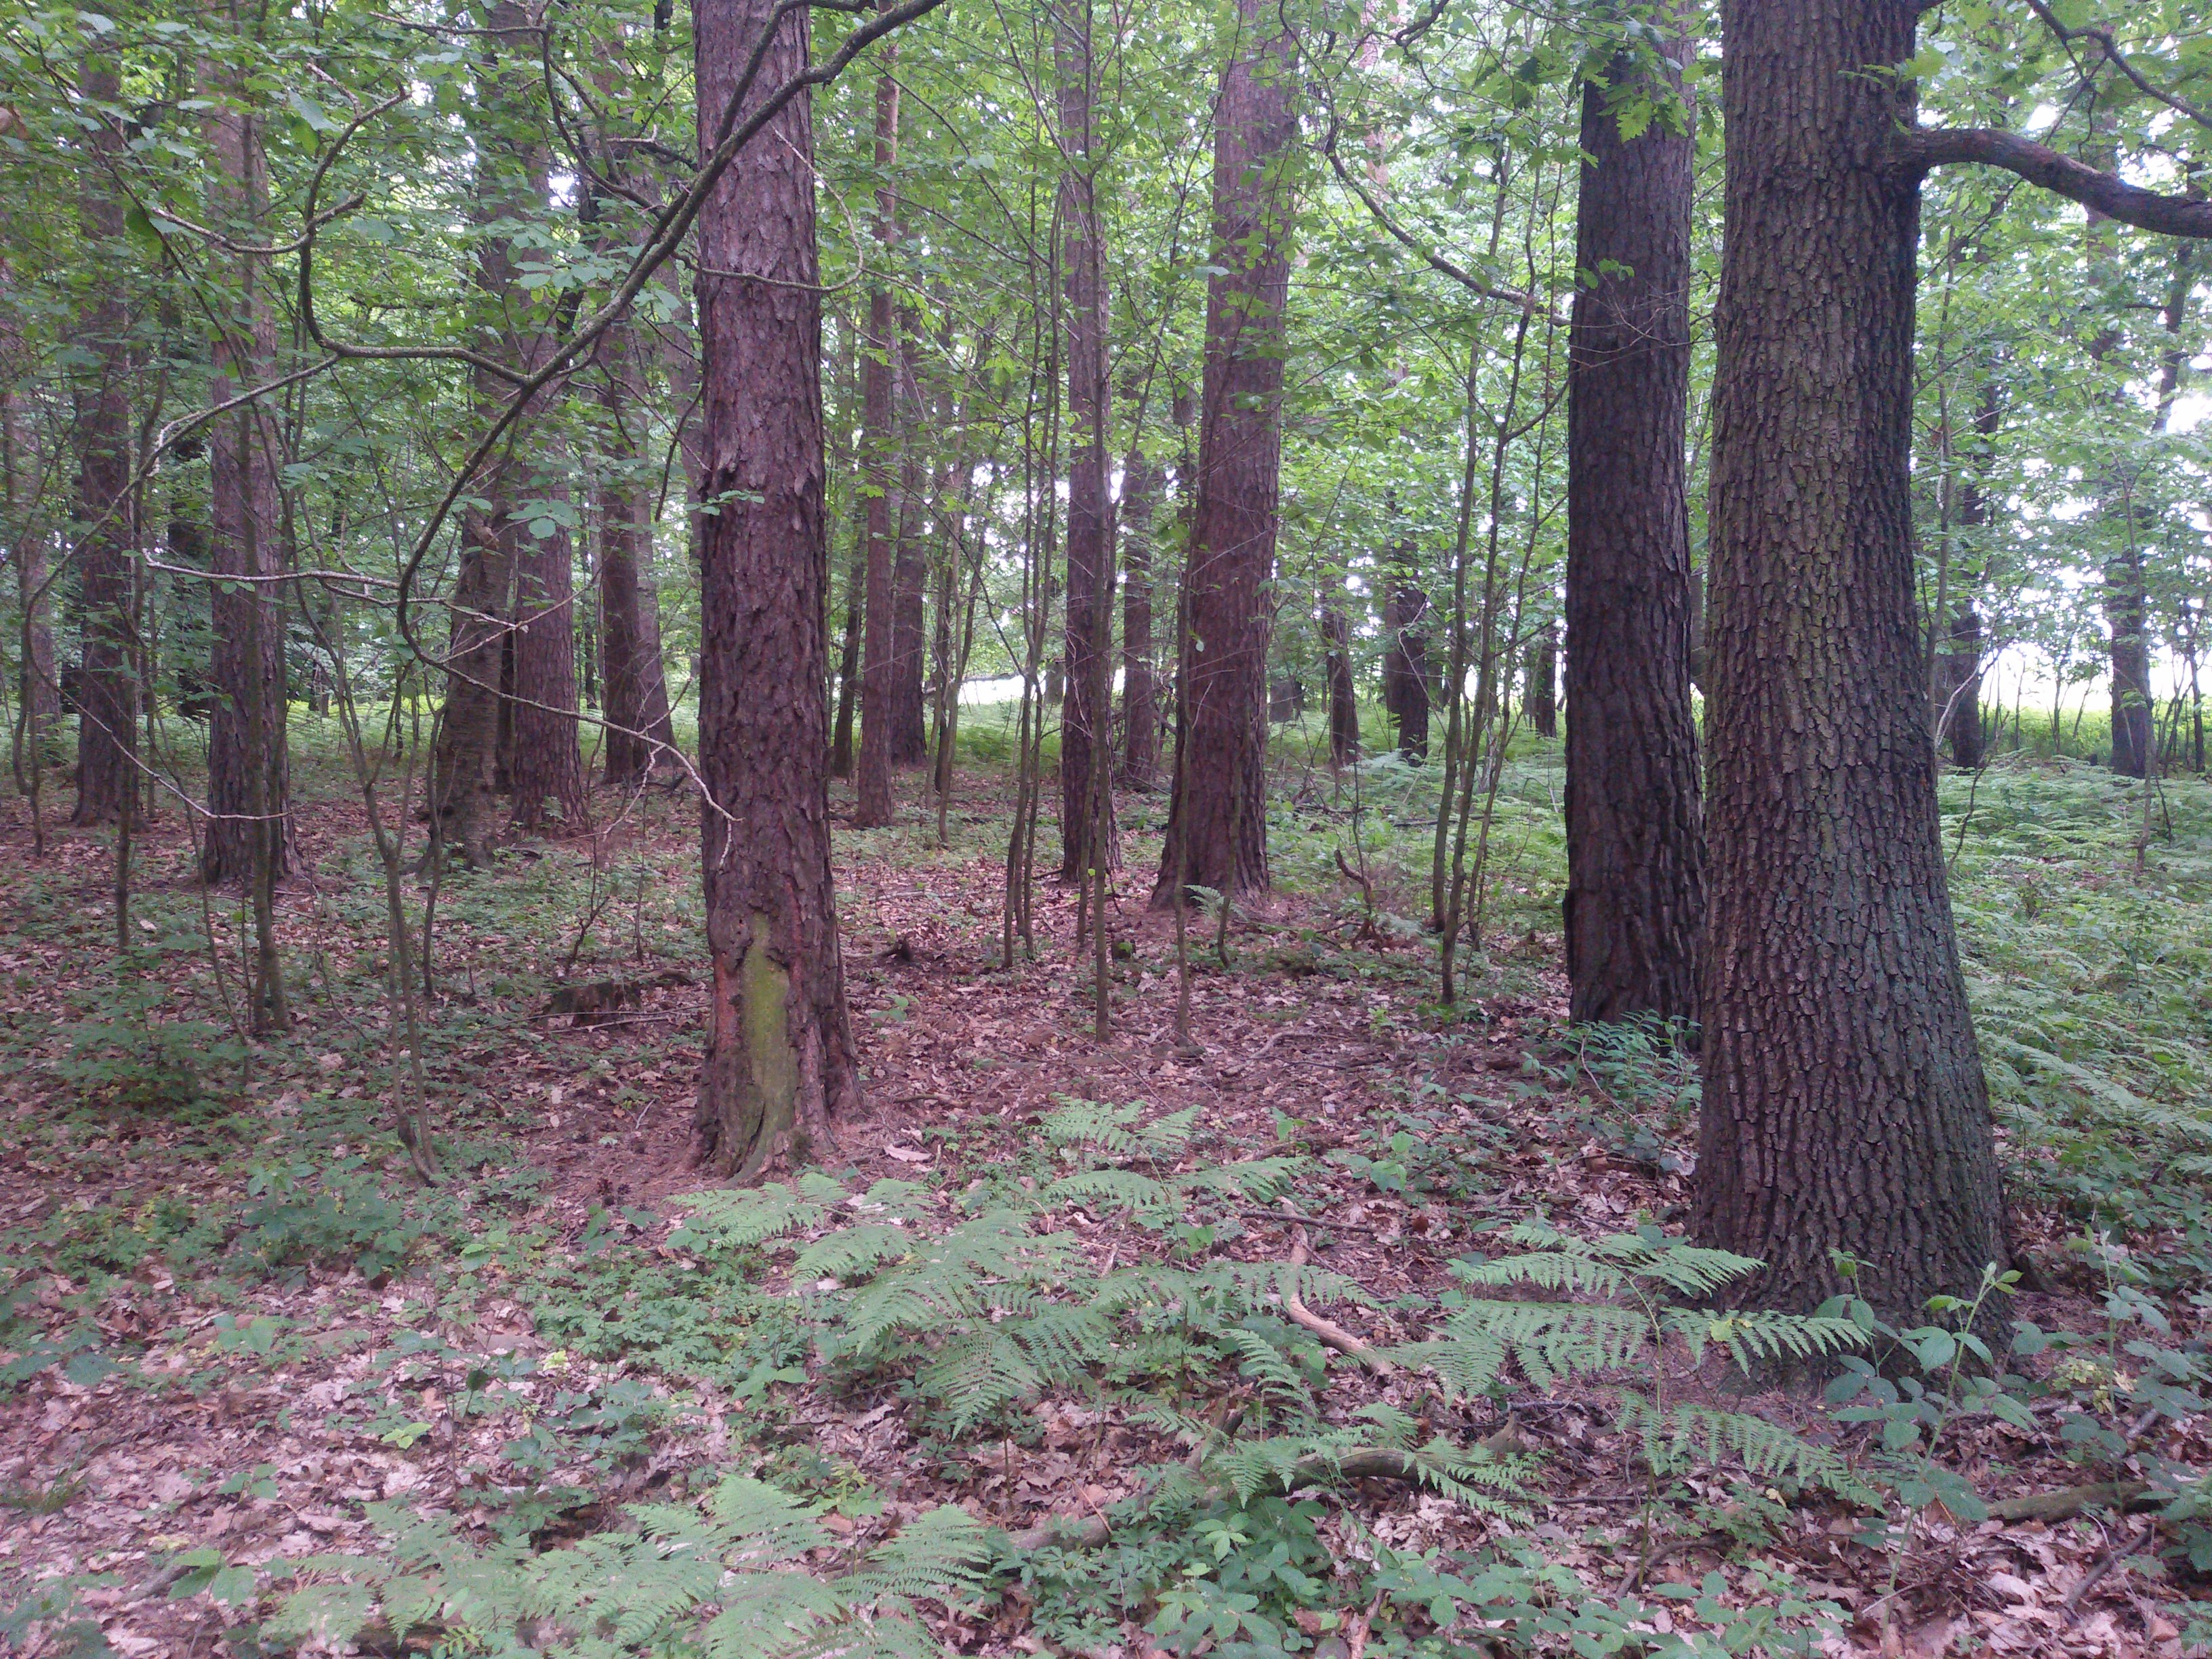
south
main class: Woodland
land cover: Pine dominated mixed woodland
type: hemiboreal forest and nemoral coniferous forest and mixed broadleaved-coniferous forest
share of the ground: > 75 %
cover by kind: coniferous forest trees 60 %, broadleaved forest trees 30 %, herbaceous plants 5 %, lichens and mosses 5 %
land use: Forestry
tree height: > 5 m
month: May
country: PL
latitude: 50.5705
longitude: 17.1978
